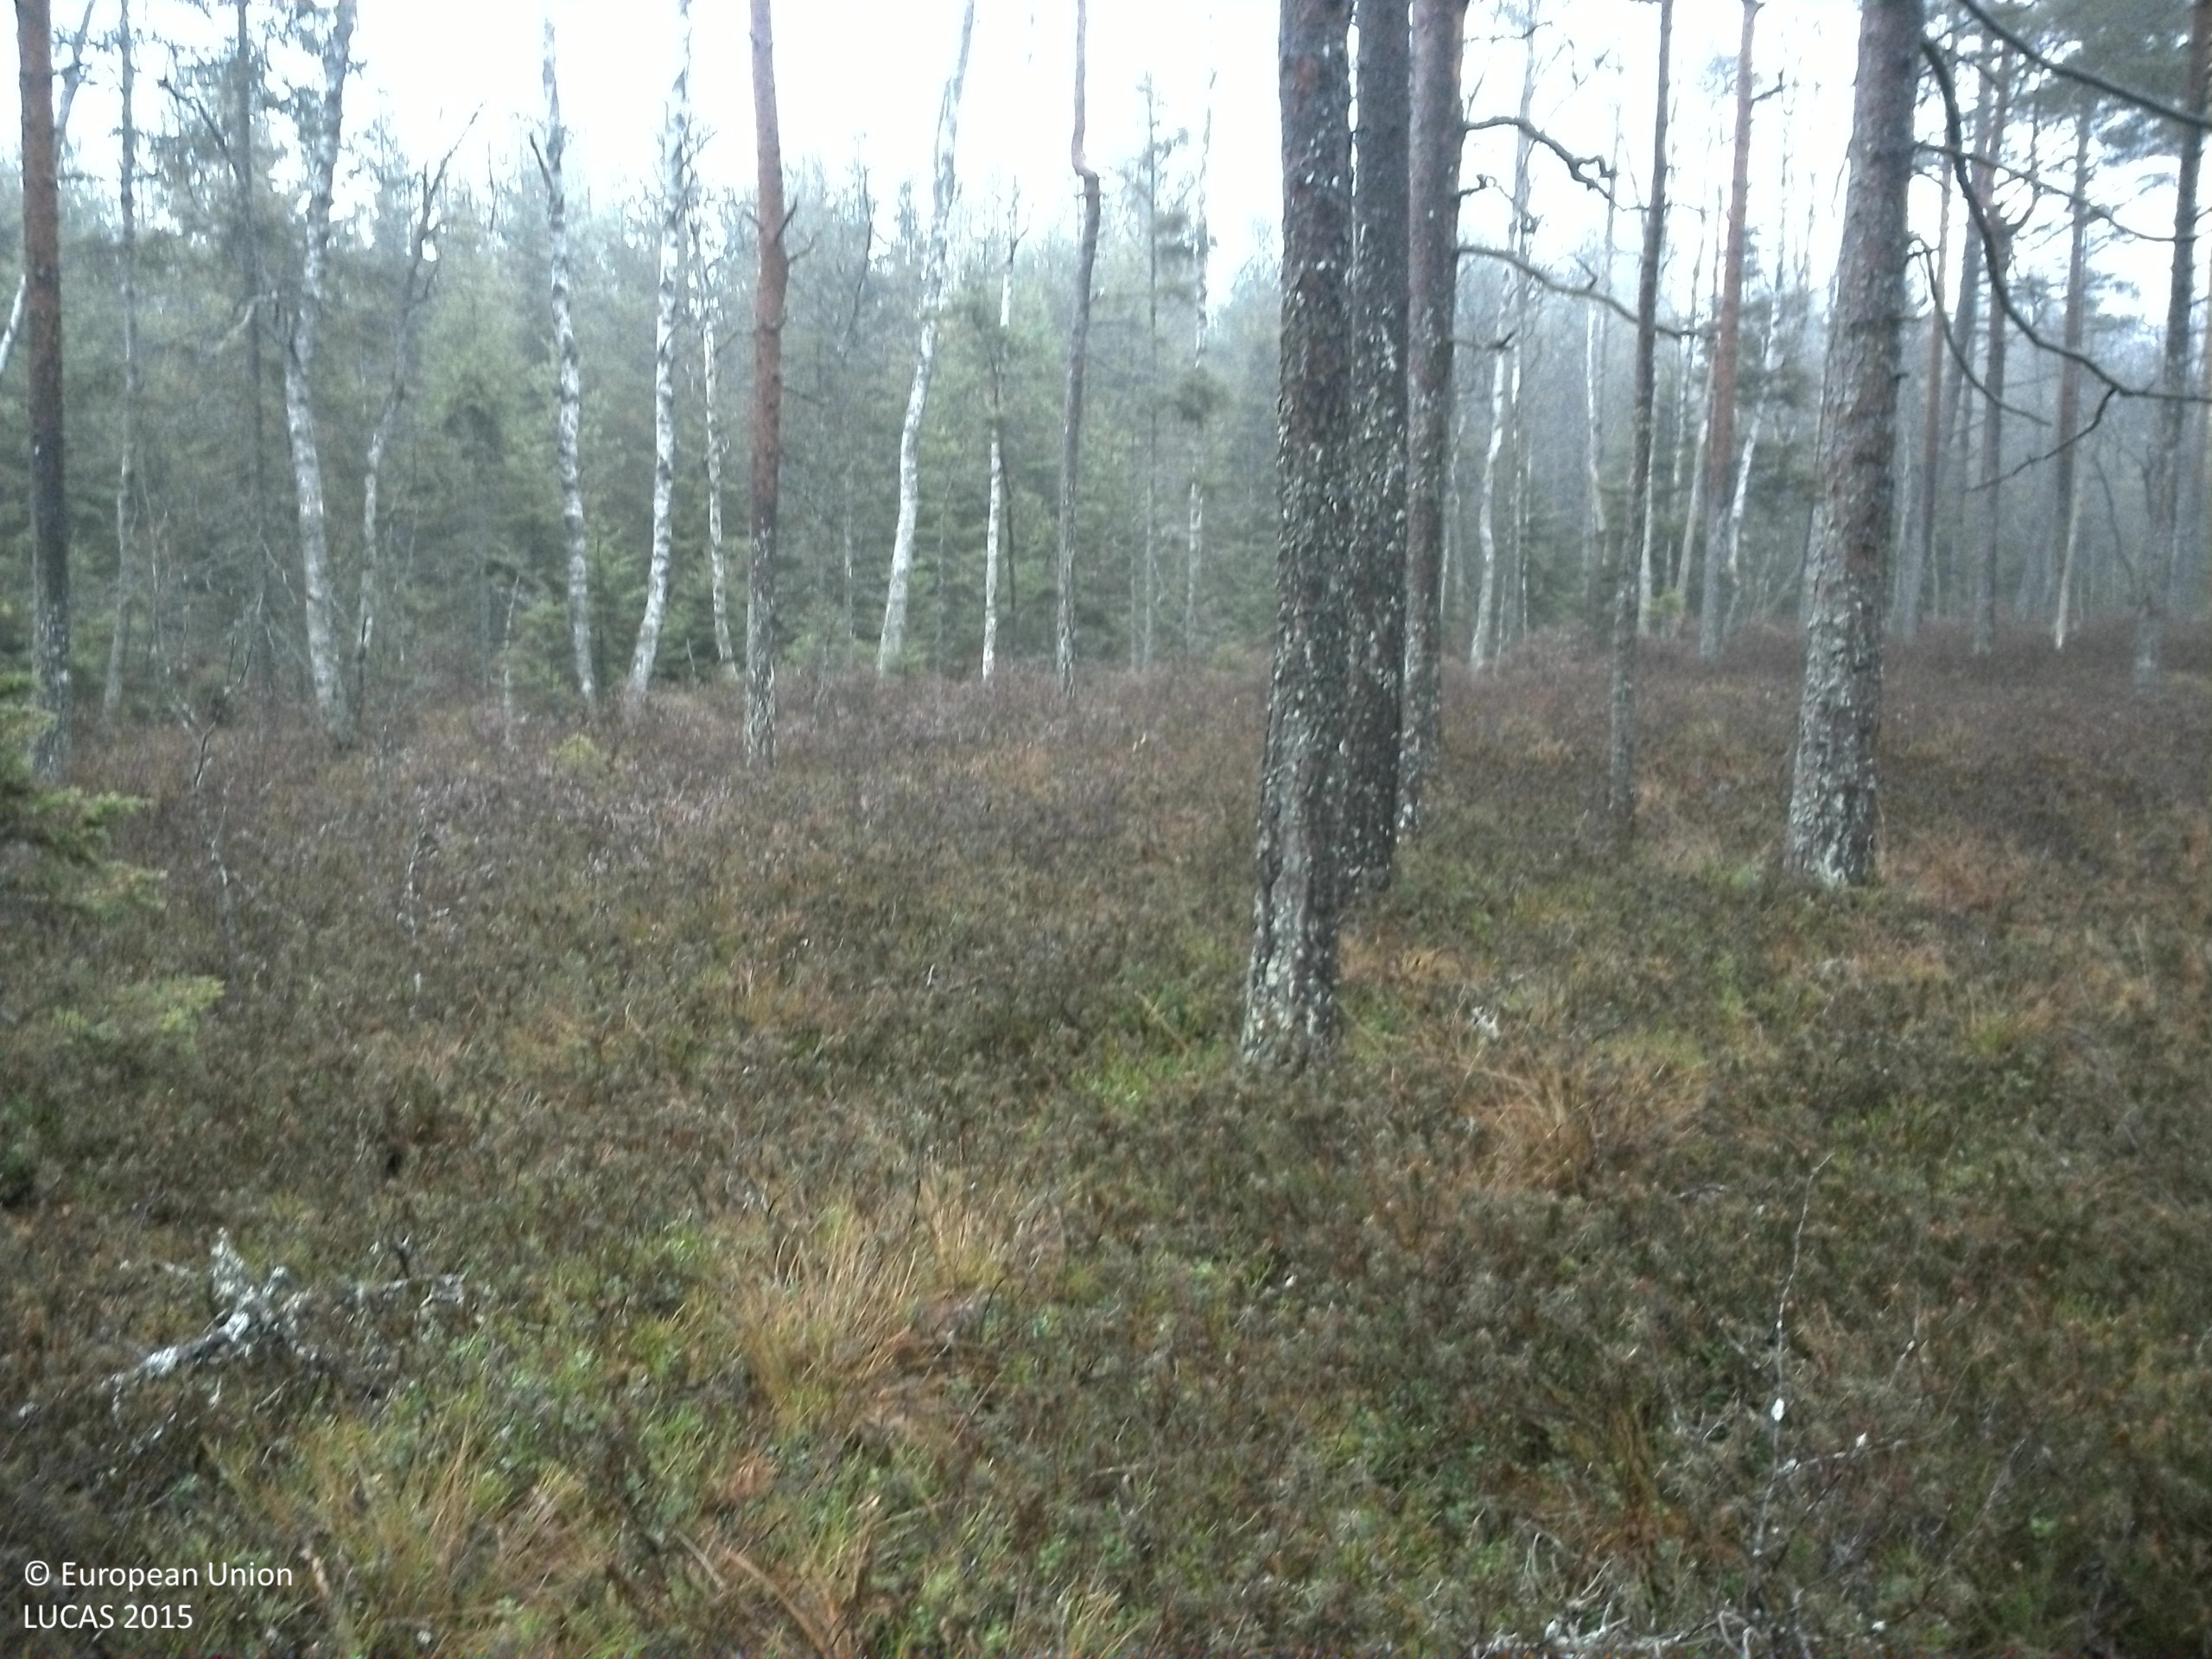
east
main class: Woodland
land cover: Pine dominated coniferous woodland
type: mire and swamp forests
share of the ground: 50 - 75 %
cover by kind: coniferous forest trees 60 %, shrubs 20 %, lichens and mosses 20 %
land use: Forestry
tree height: > 5 m
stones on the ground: < 10 %
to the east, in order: Pine dominated coniferous woodland; Spruce dominated coniferous woodland; Paved roads, cycling and walking lanes; Spruce dominated coniferous woodland; Ditches and canals; Spruce dominated mixed woodland; Grassland with sparse tree/shrub cover; Rivers and streams; Spruce dominated mixed woodland
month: November
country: SE
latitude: 57.7051
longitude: 15.1813
